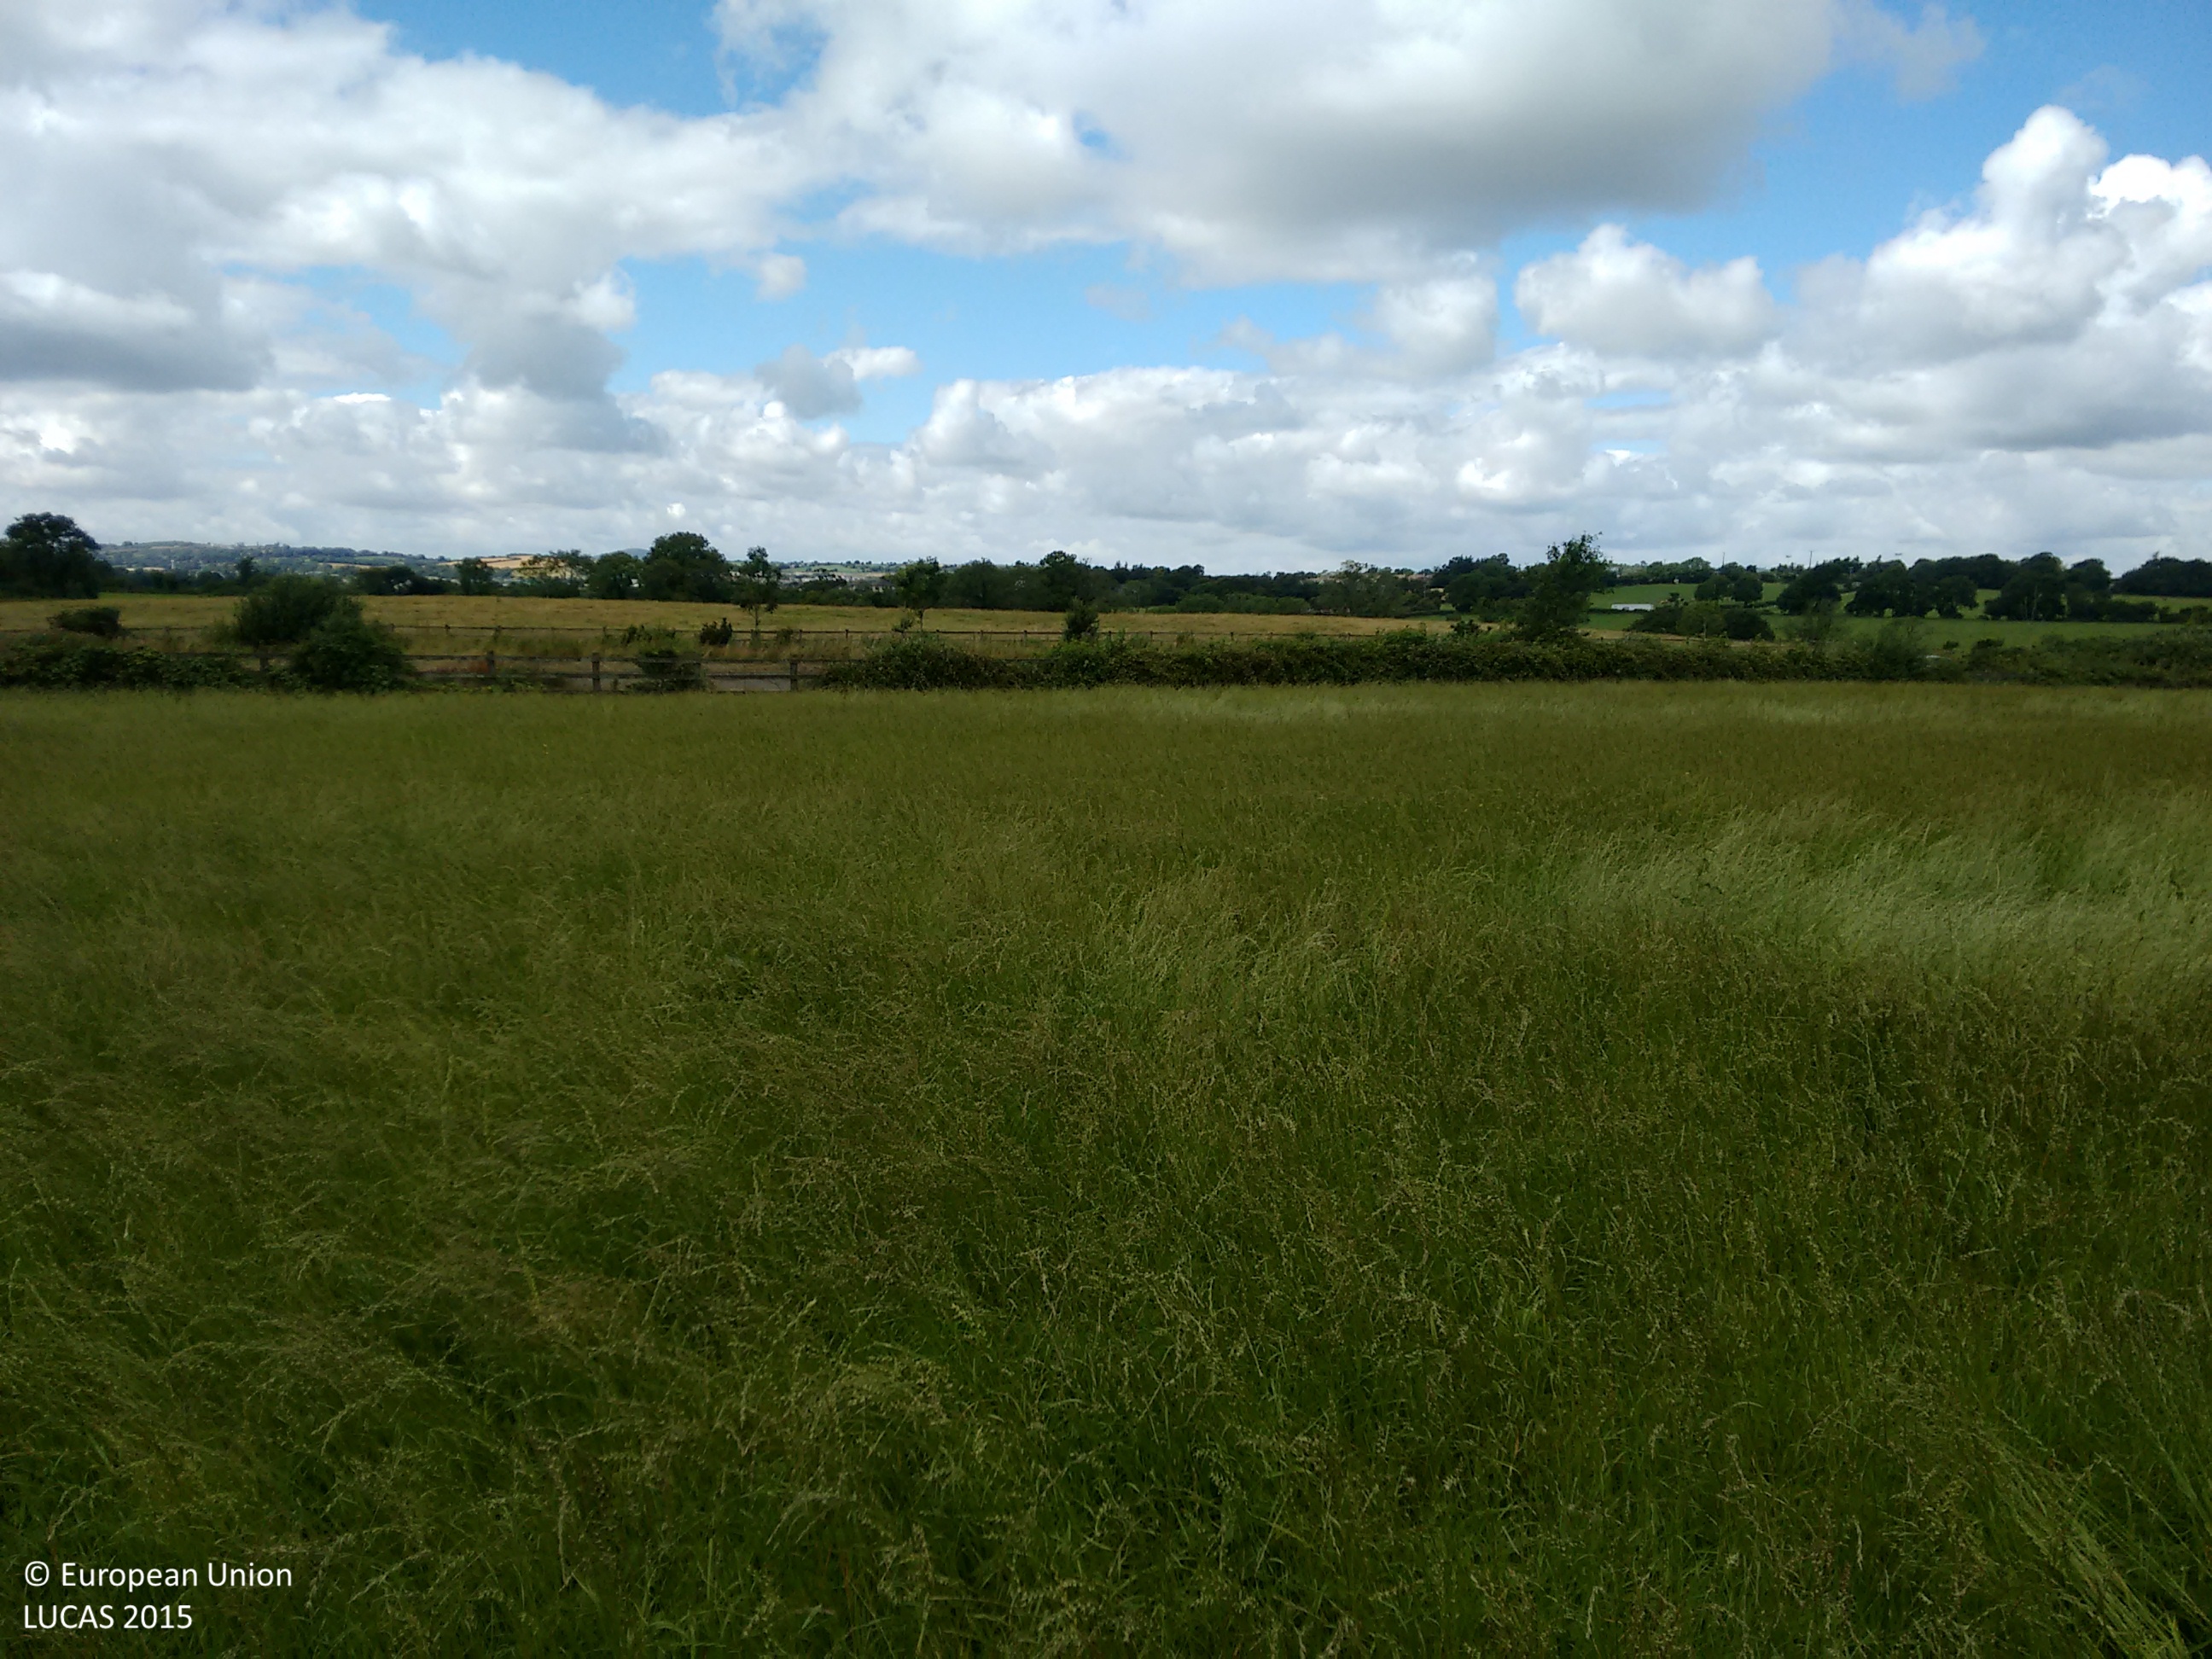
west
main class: Grassland
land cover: Grassland without tree/shrub cover
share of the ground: > 75 %
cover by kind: herbaceous plants 100 %
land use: Agriculture (excluding fallow land and kitchen gardens)
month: August
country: IE
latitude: 52.6781
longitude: -6.2573
